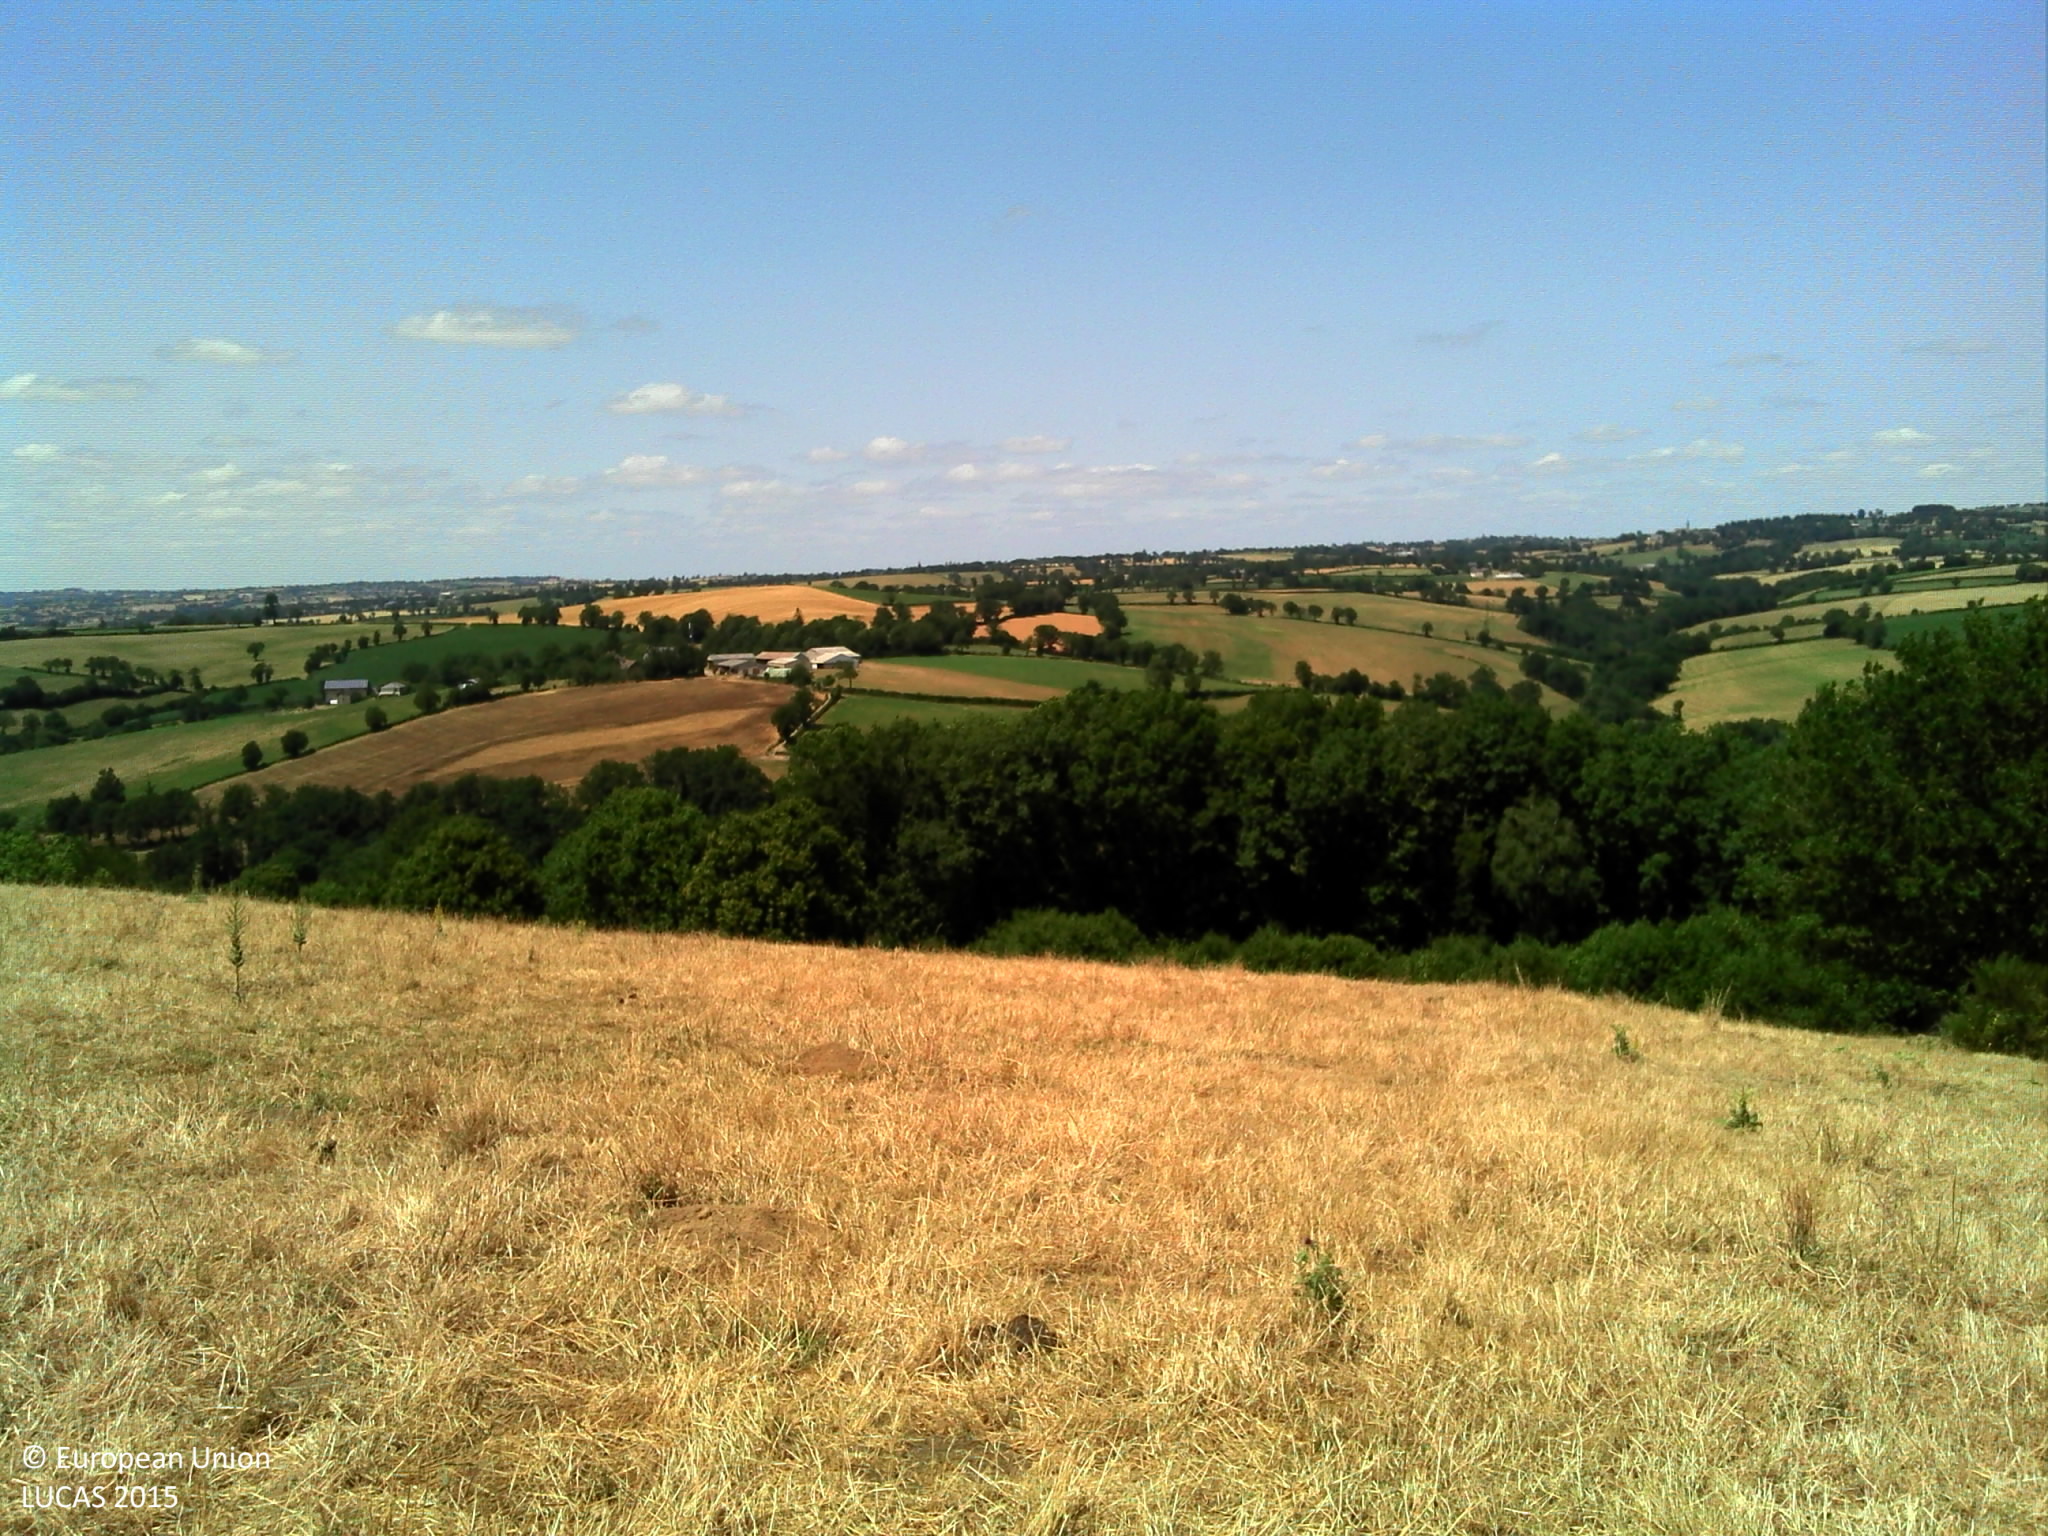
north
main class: Grassland
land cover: Grassland without tree/shrub cover
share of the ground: > 75 %
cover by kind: herbaceous plants 100 %
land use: Agriculture (excluding fallow land and kitchen gardens)
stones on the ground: 10 - 25 %
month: July
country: FR
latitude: 44.1757
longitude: 2.5870
